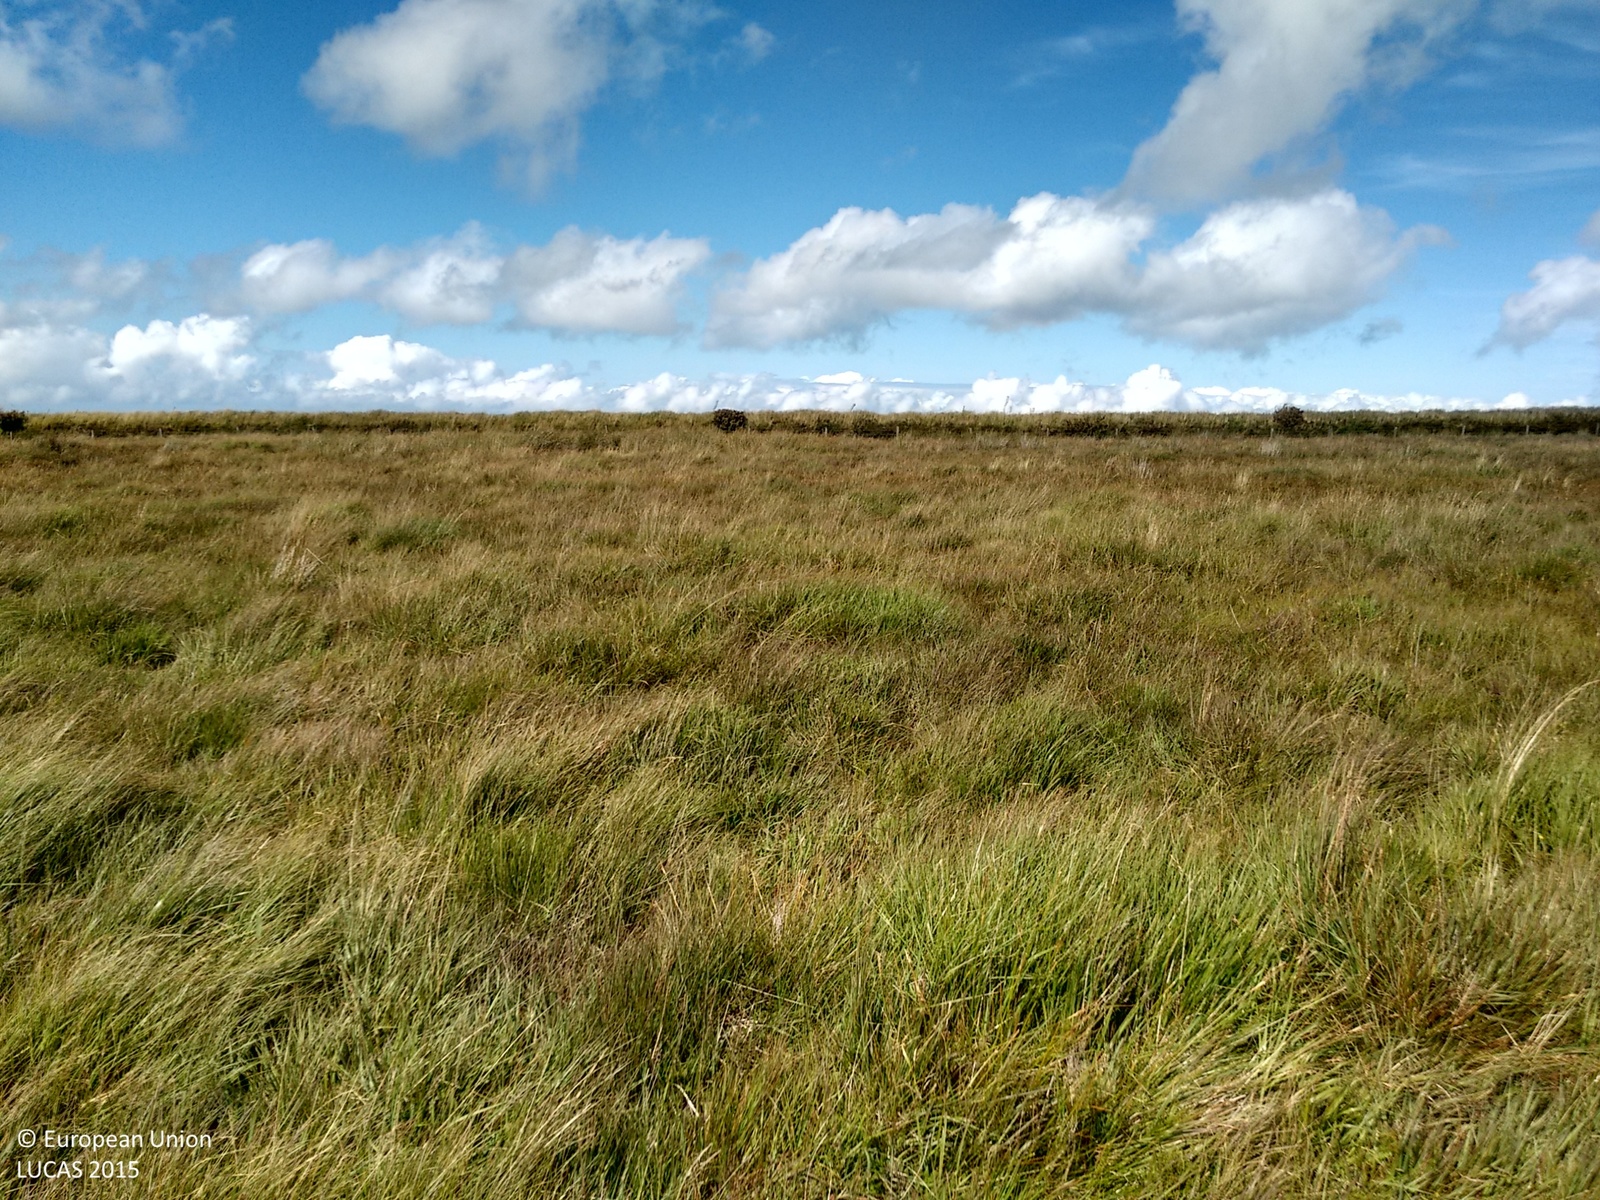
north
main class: Grassland
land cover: Grassland without tree/shrub cover
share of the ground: > 75 %
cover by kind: herbaceous plants 100 %
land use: Agriculture (excluding fallow land and kitchen gardens)
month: August
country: GB
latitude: 51.1751
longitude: -3.8661
